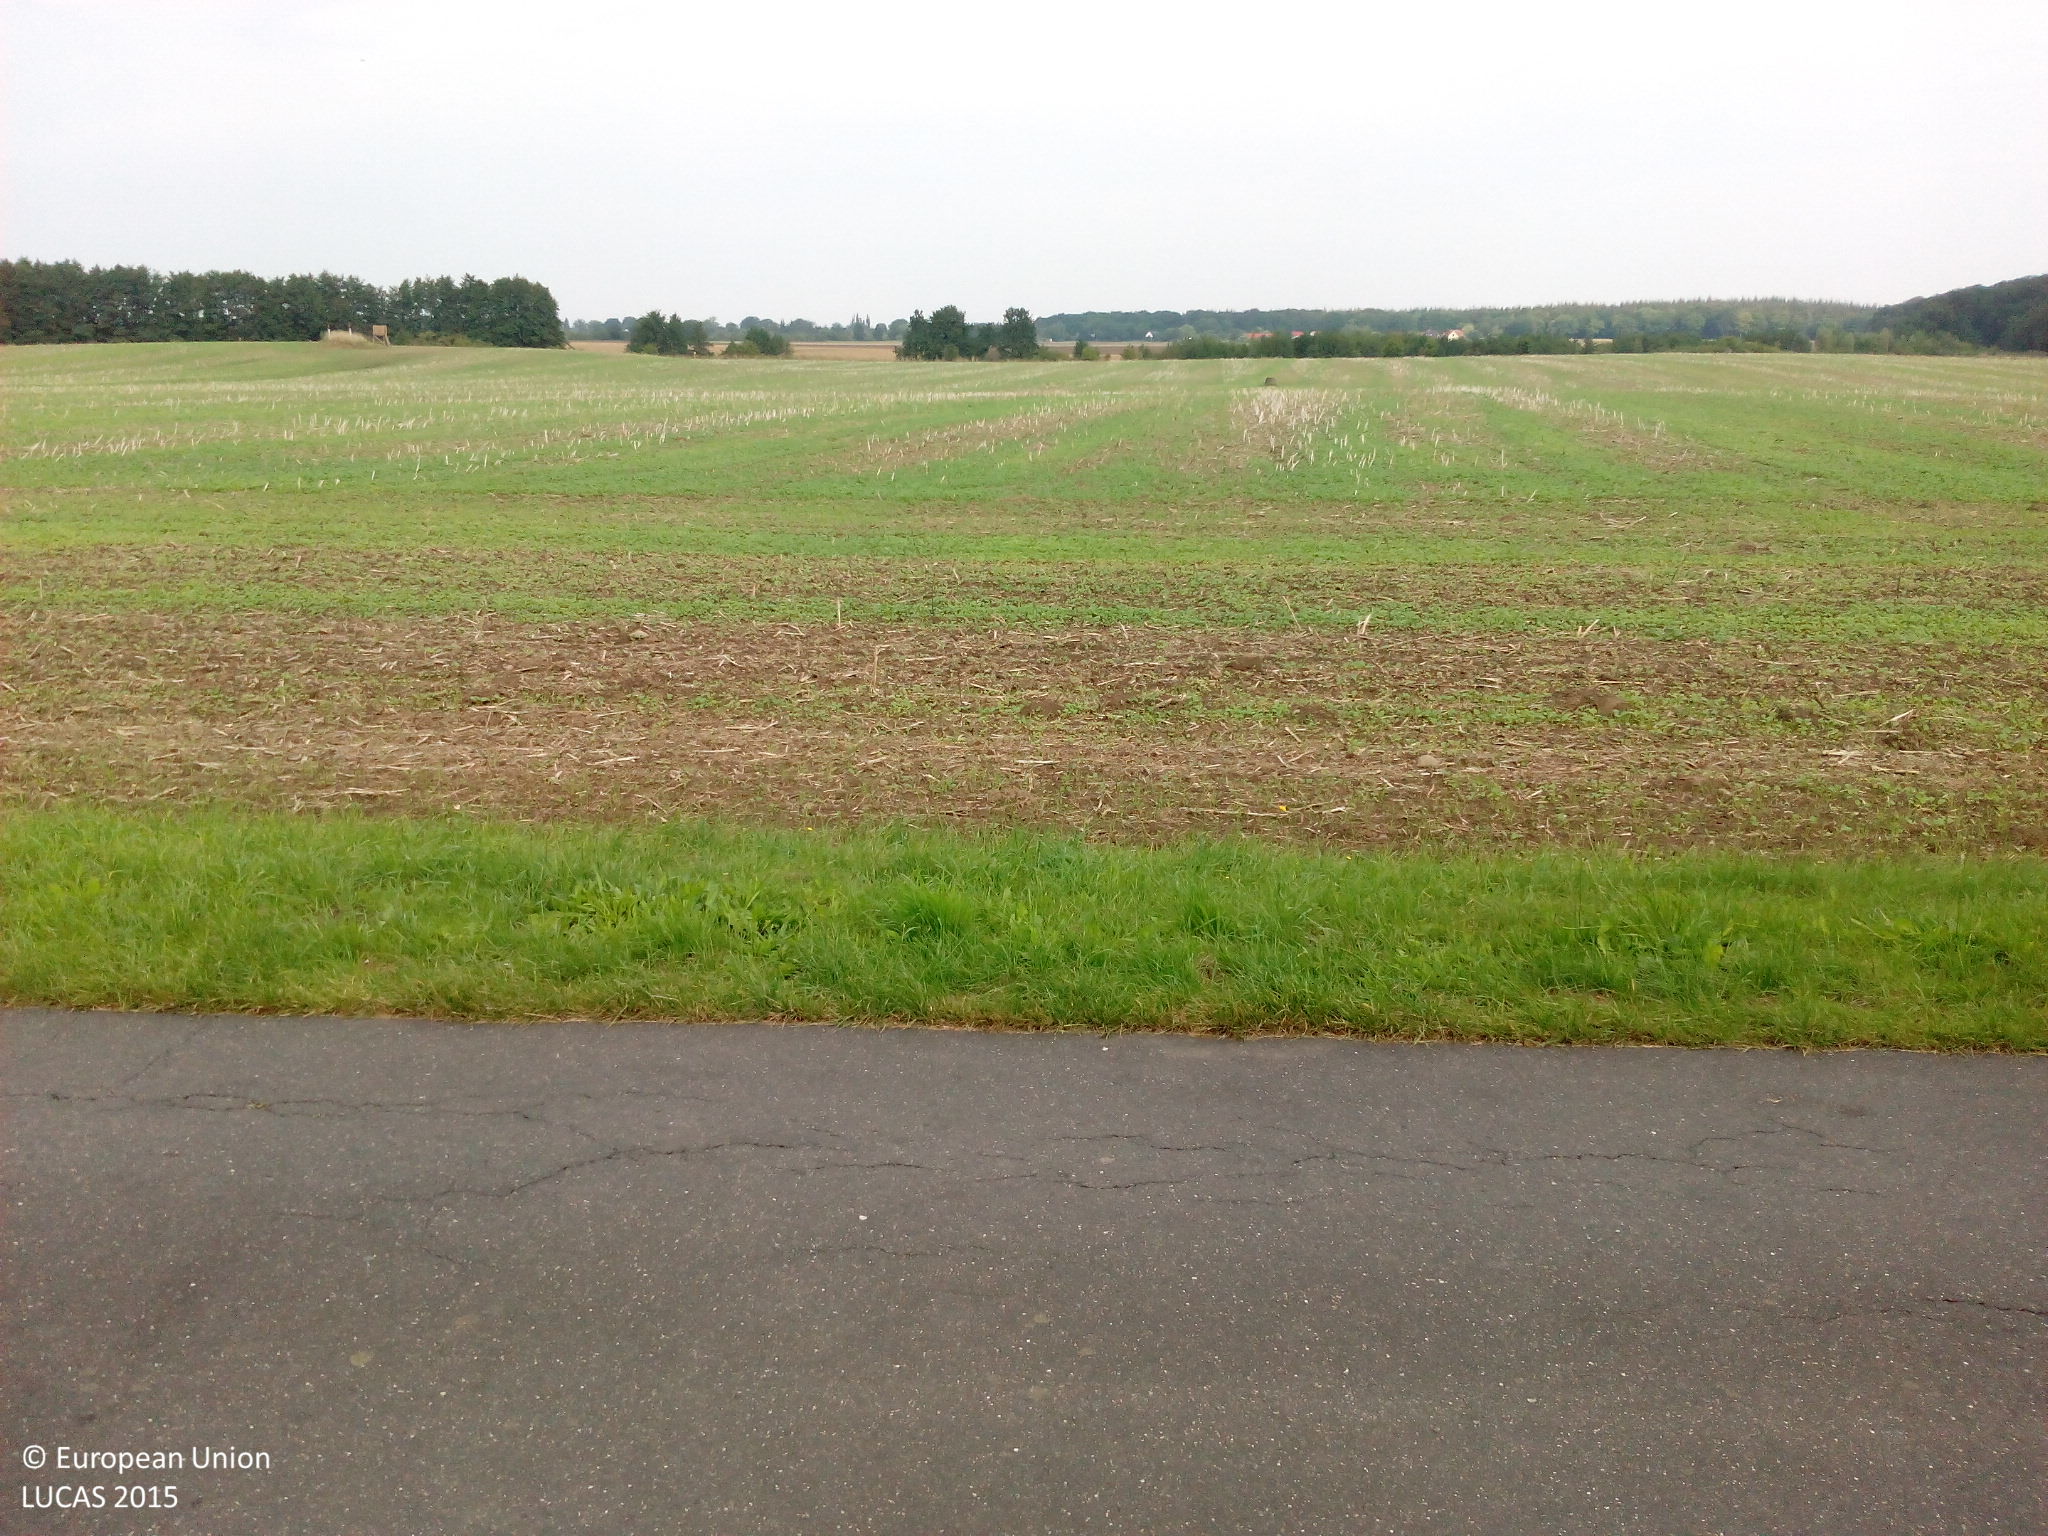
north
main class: Cropland
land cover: Rape and turnip rape
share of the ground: 10 - 25 %
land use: Agriculture (excluding fallow land and kitchen gardens)
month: August
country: DE
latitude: 54.2008
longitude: 12.6204
